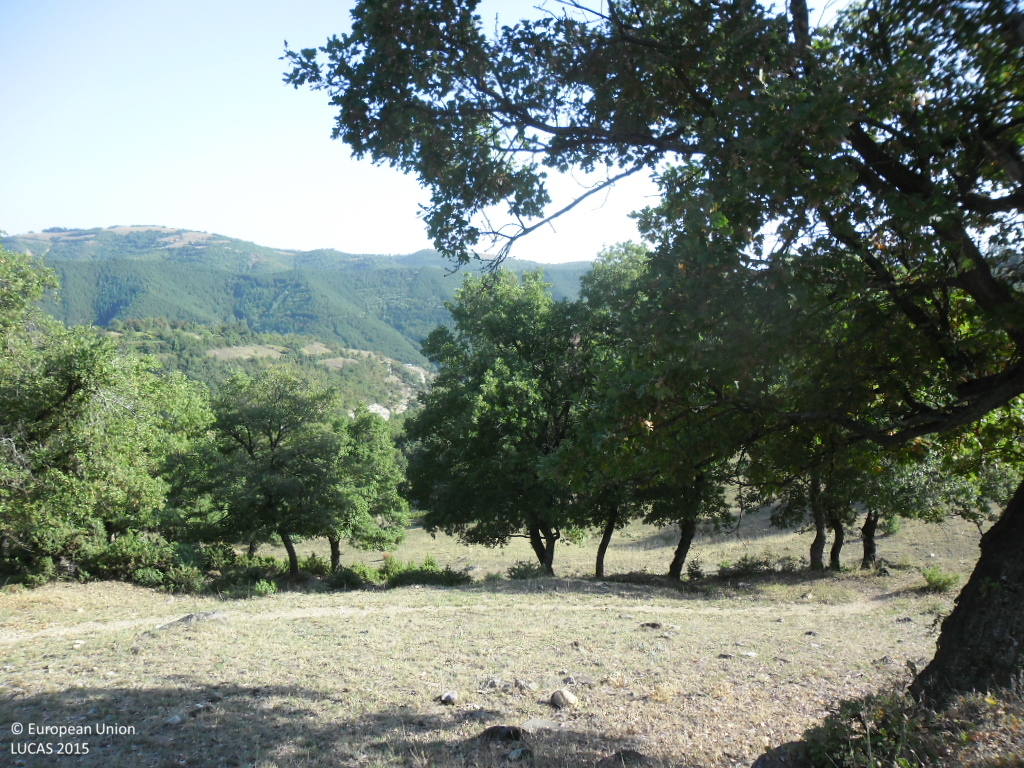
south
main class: Grassland
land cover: Grassland with sparse tree/shrub cover
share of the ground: > 75 %
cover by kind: herbaceous plants 90 %, broadleaved forest trees 5 %, shrubs 5 %
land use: Agriculture (excluding fallow land and kitchen gardens)
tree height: < 5 m
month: September
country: BG
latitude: 41.6250
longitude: 23.3098
